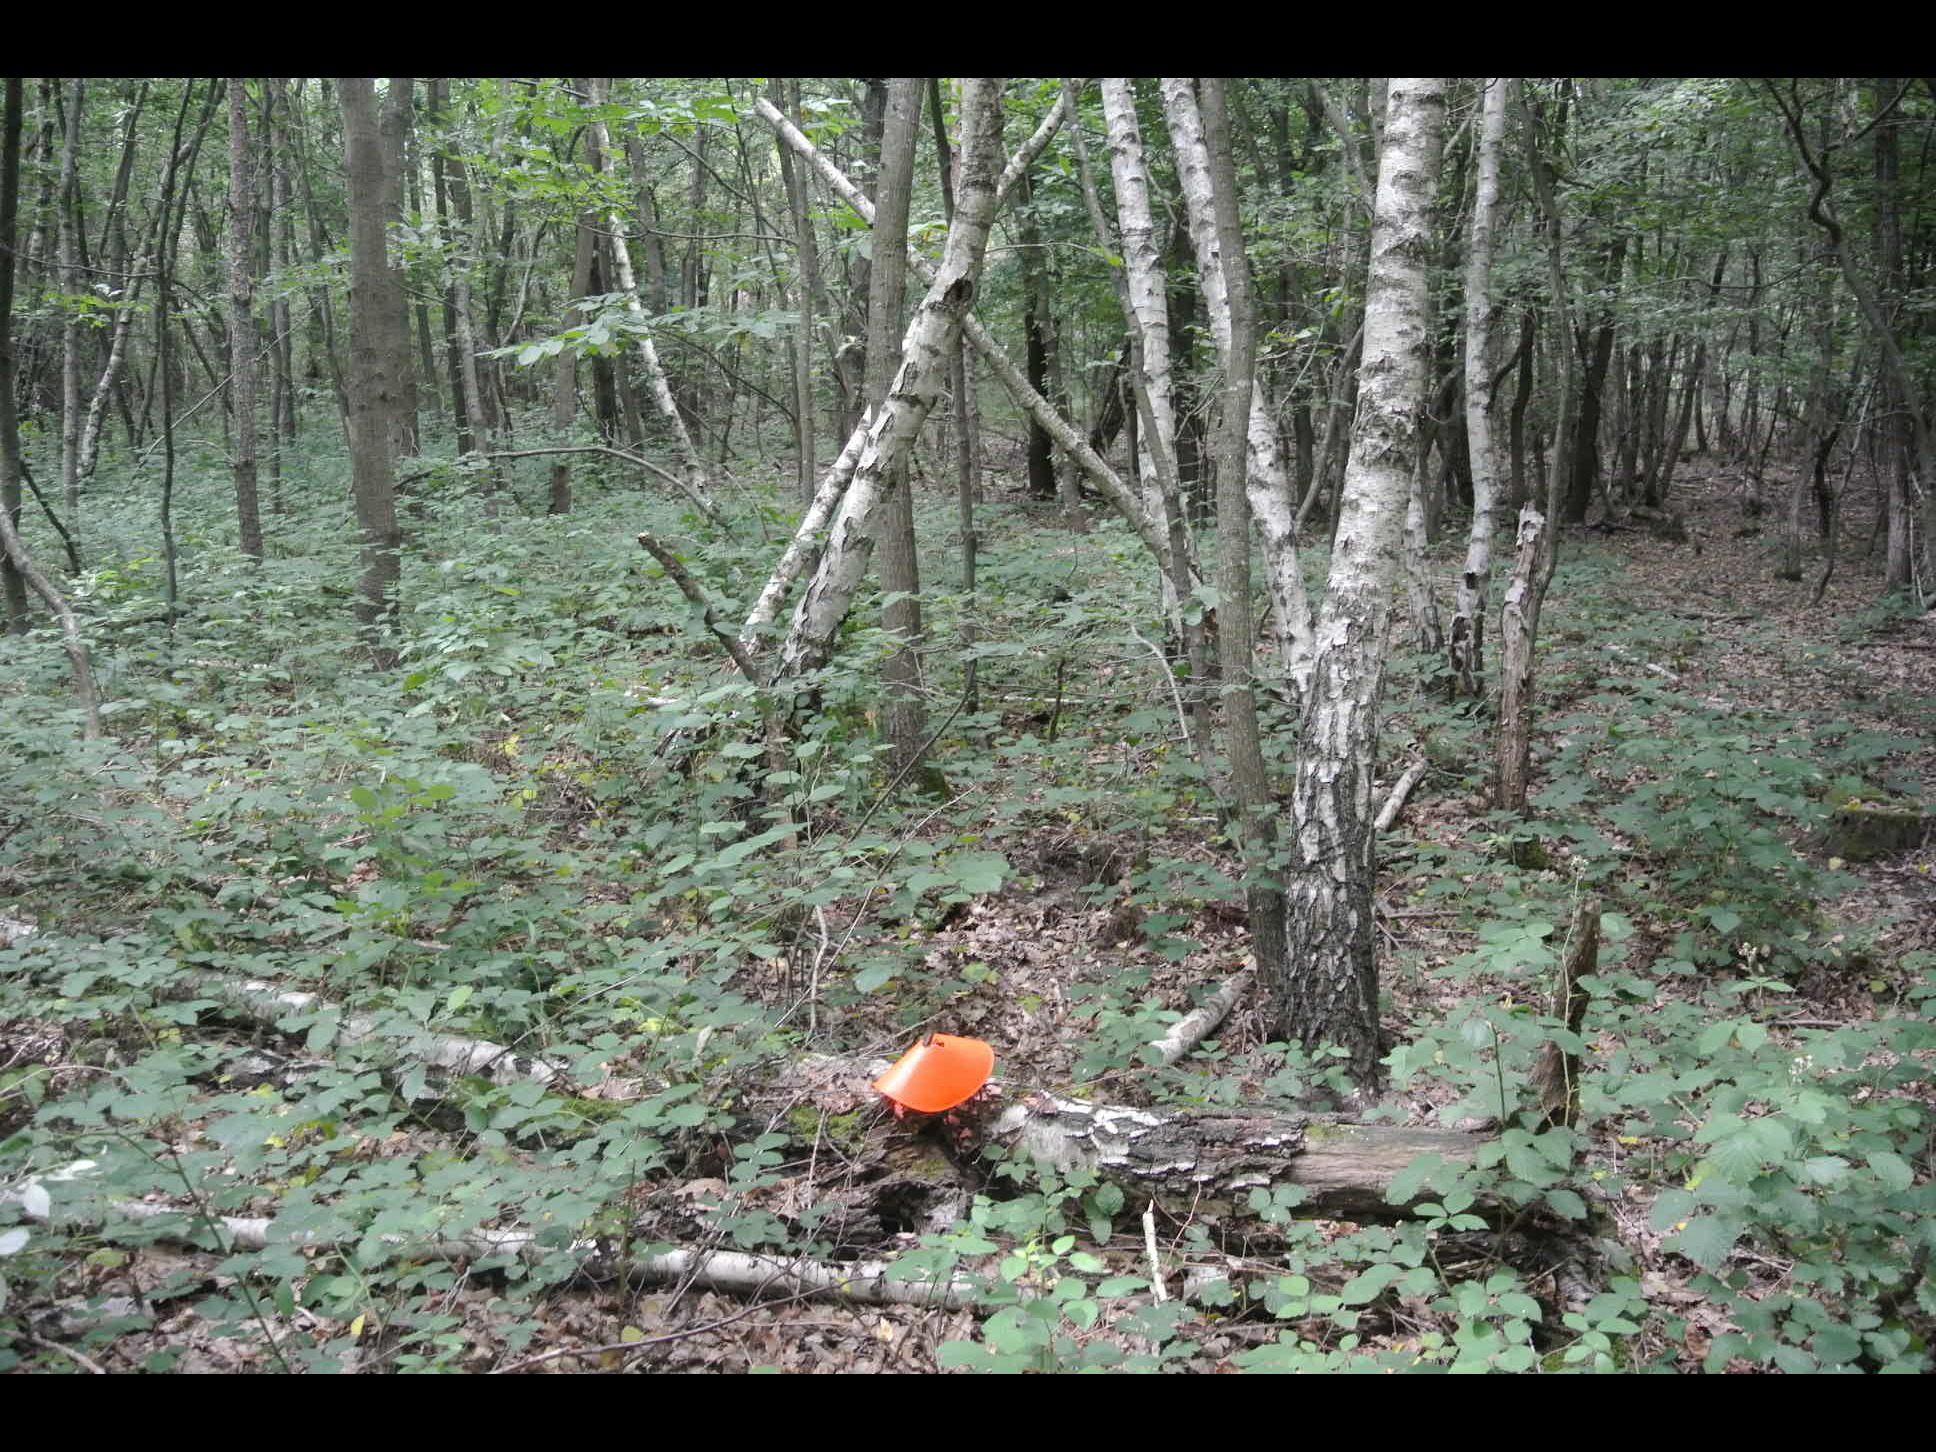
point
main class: Woodland
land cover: Broadleaved woodland
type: beech forest
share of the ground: > 75 %
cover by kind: broadleaved forest trees 100 %
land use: Forestry
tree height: > 5 m
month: July
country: AT
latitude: 47.7265
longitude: 16.4705
